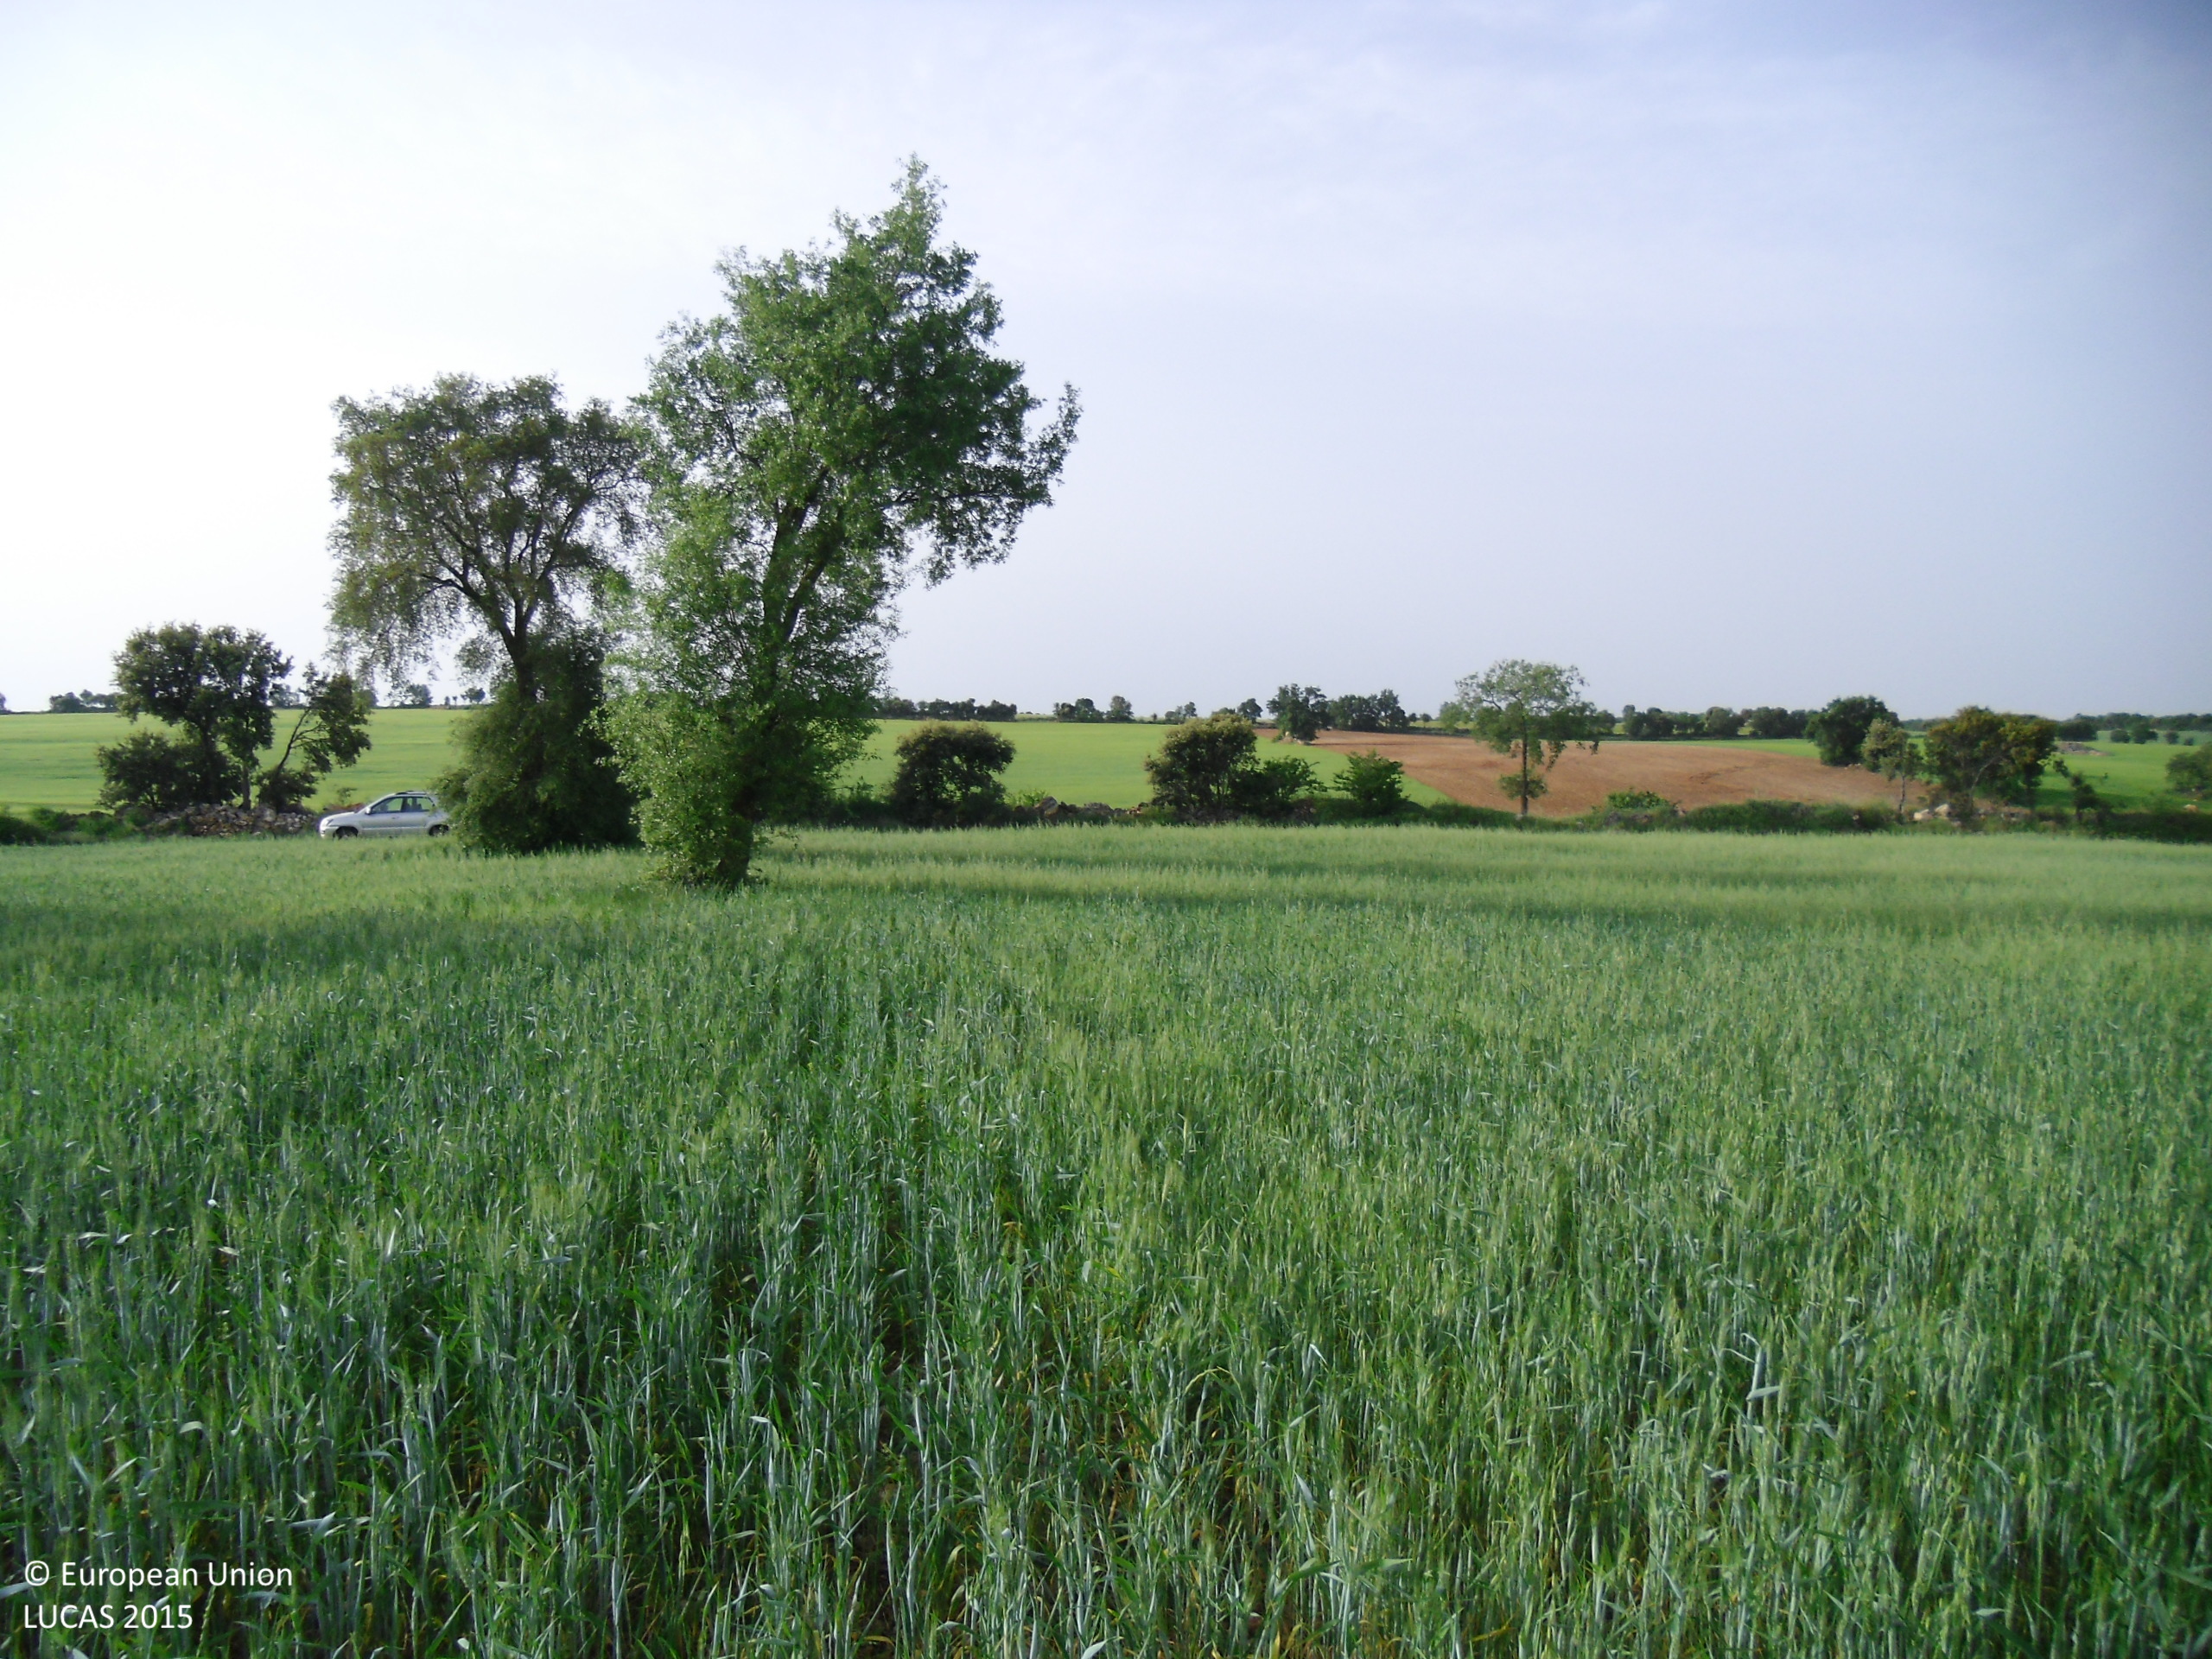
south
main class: Cropland
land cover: Common wheat
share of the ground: > 75 %
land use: Agriculture (excluding fallow land and kitchen gardens)
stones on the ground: < 10 %
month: May
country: ES
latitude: 40.5089
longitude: -2.9041
